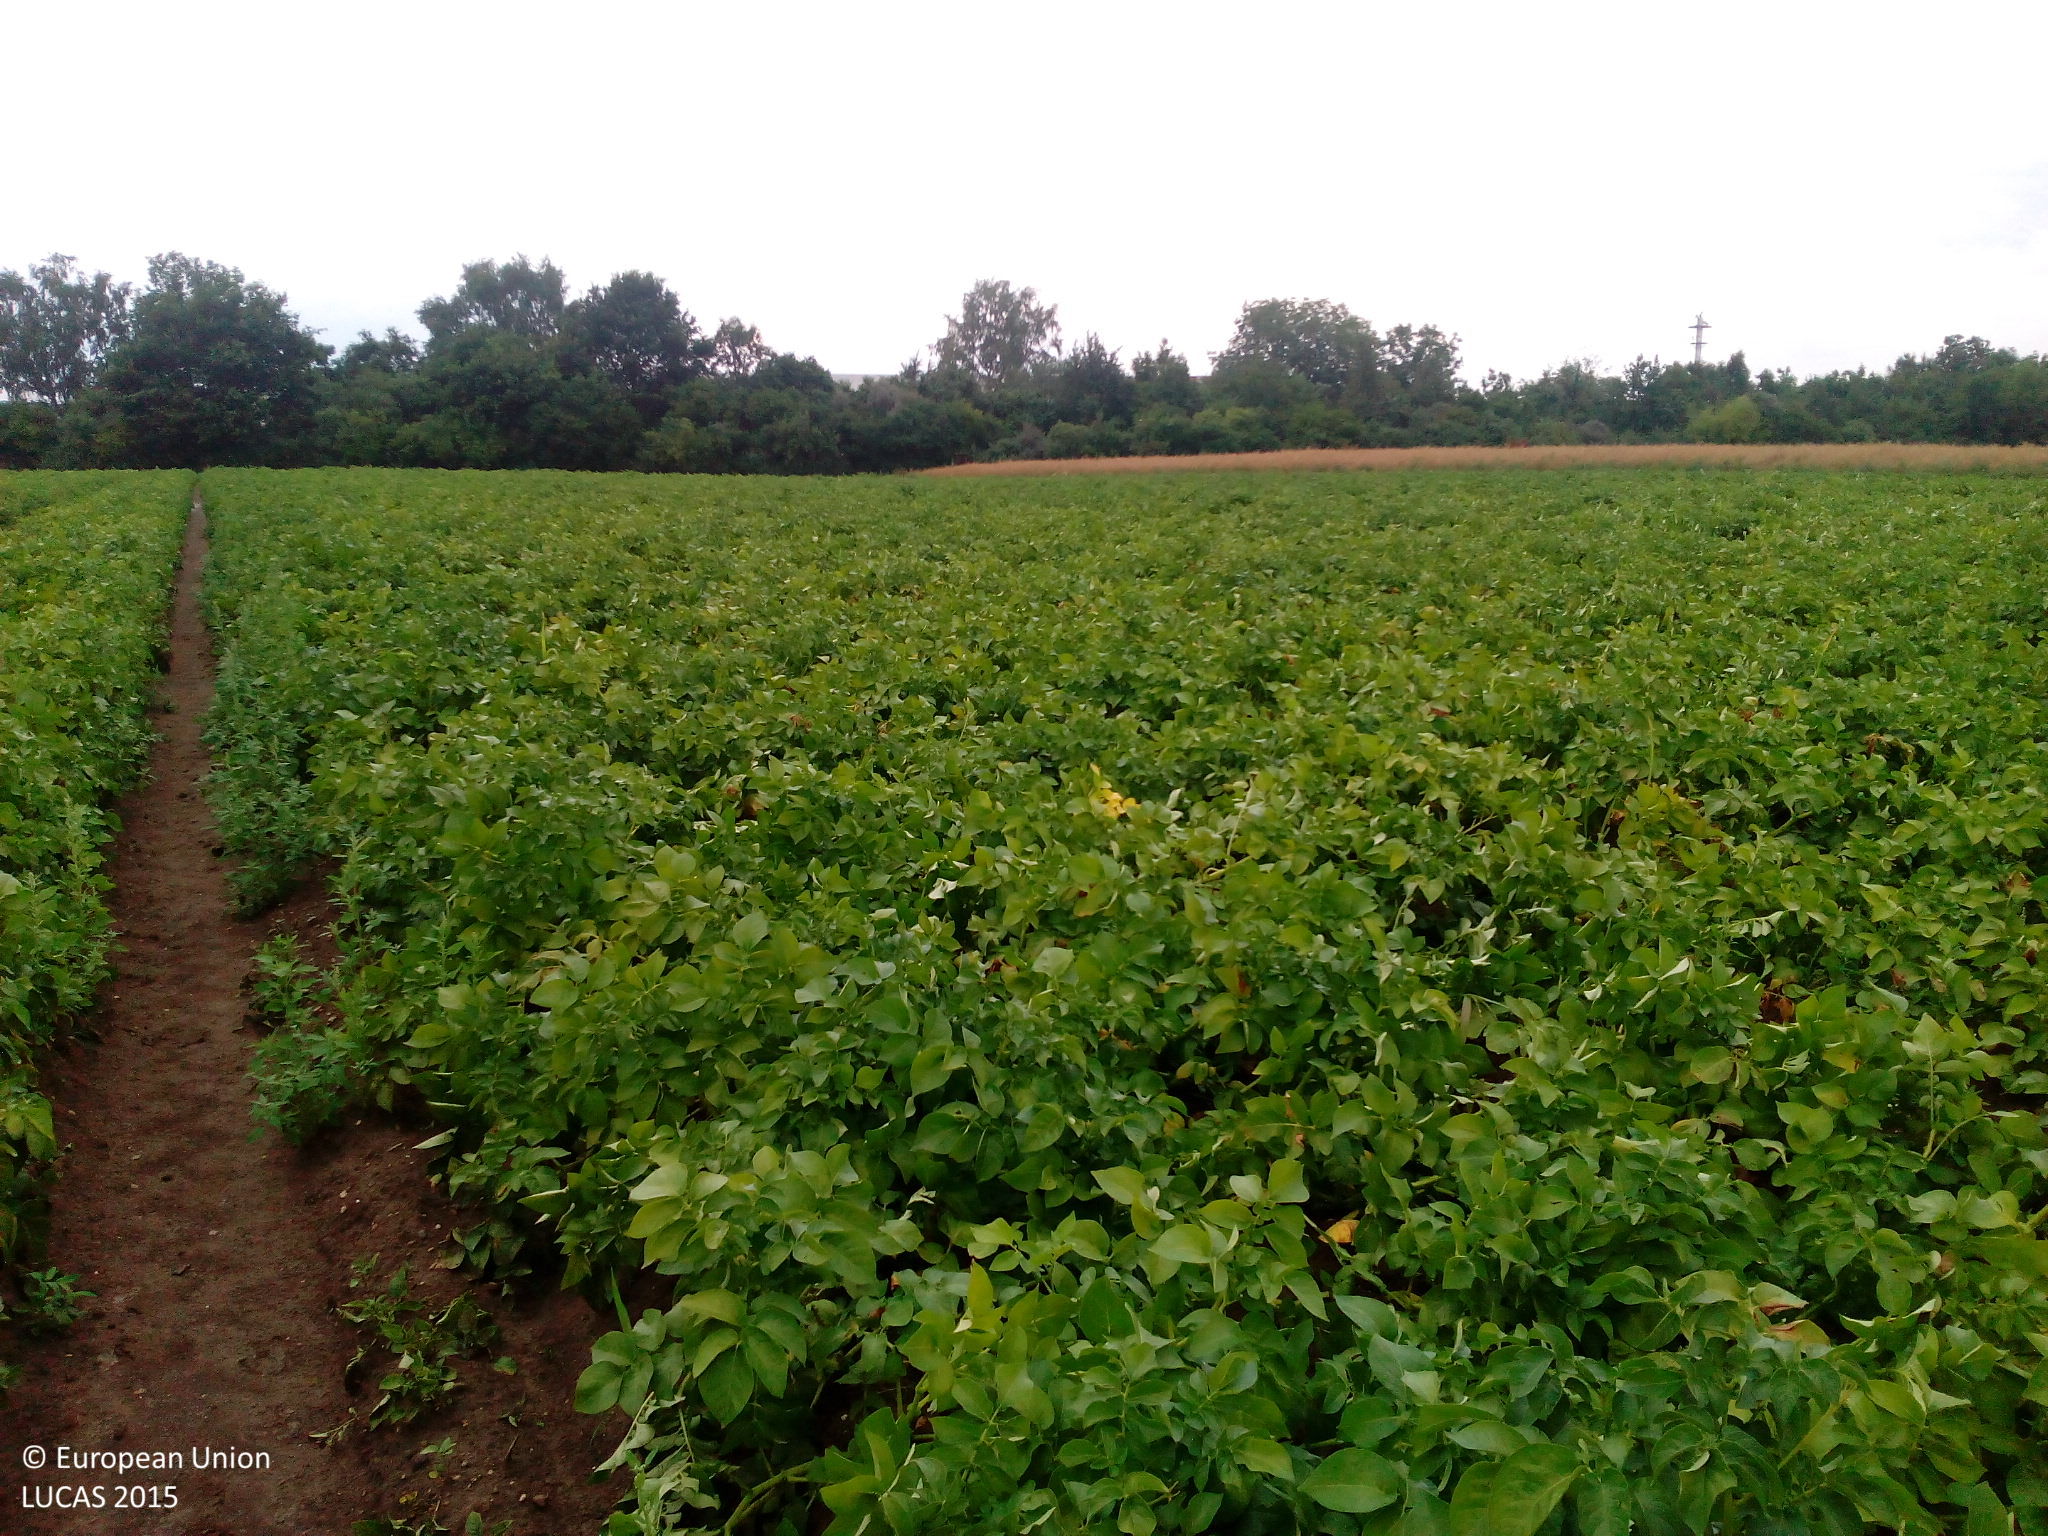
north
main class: Cropland
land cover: Potatoes
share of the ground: > 75 %
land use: Agriculture (excluding fallow land and kitchen gardens)
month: July
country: DE
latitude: 48.7002
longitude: 11.4260
